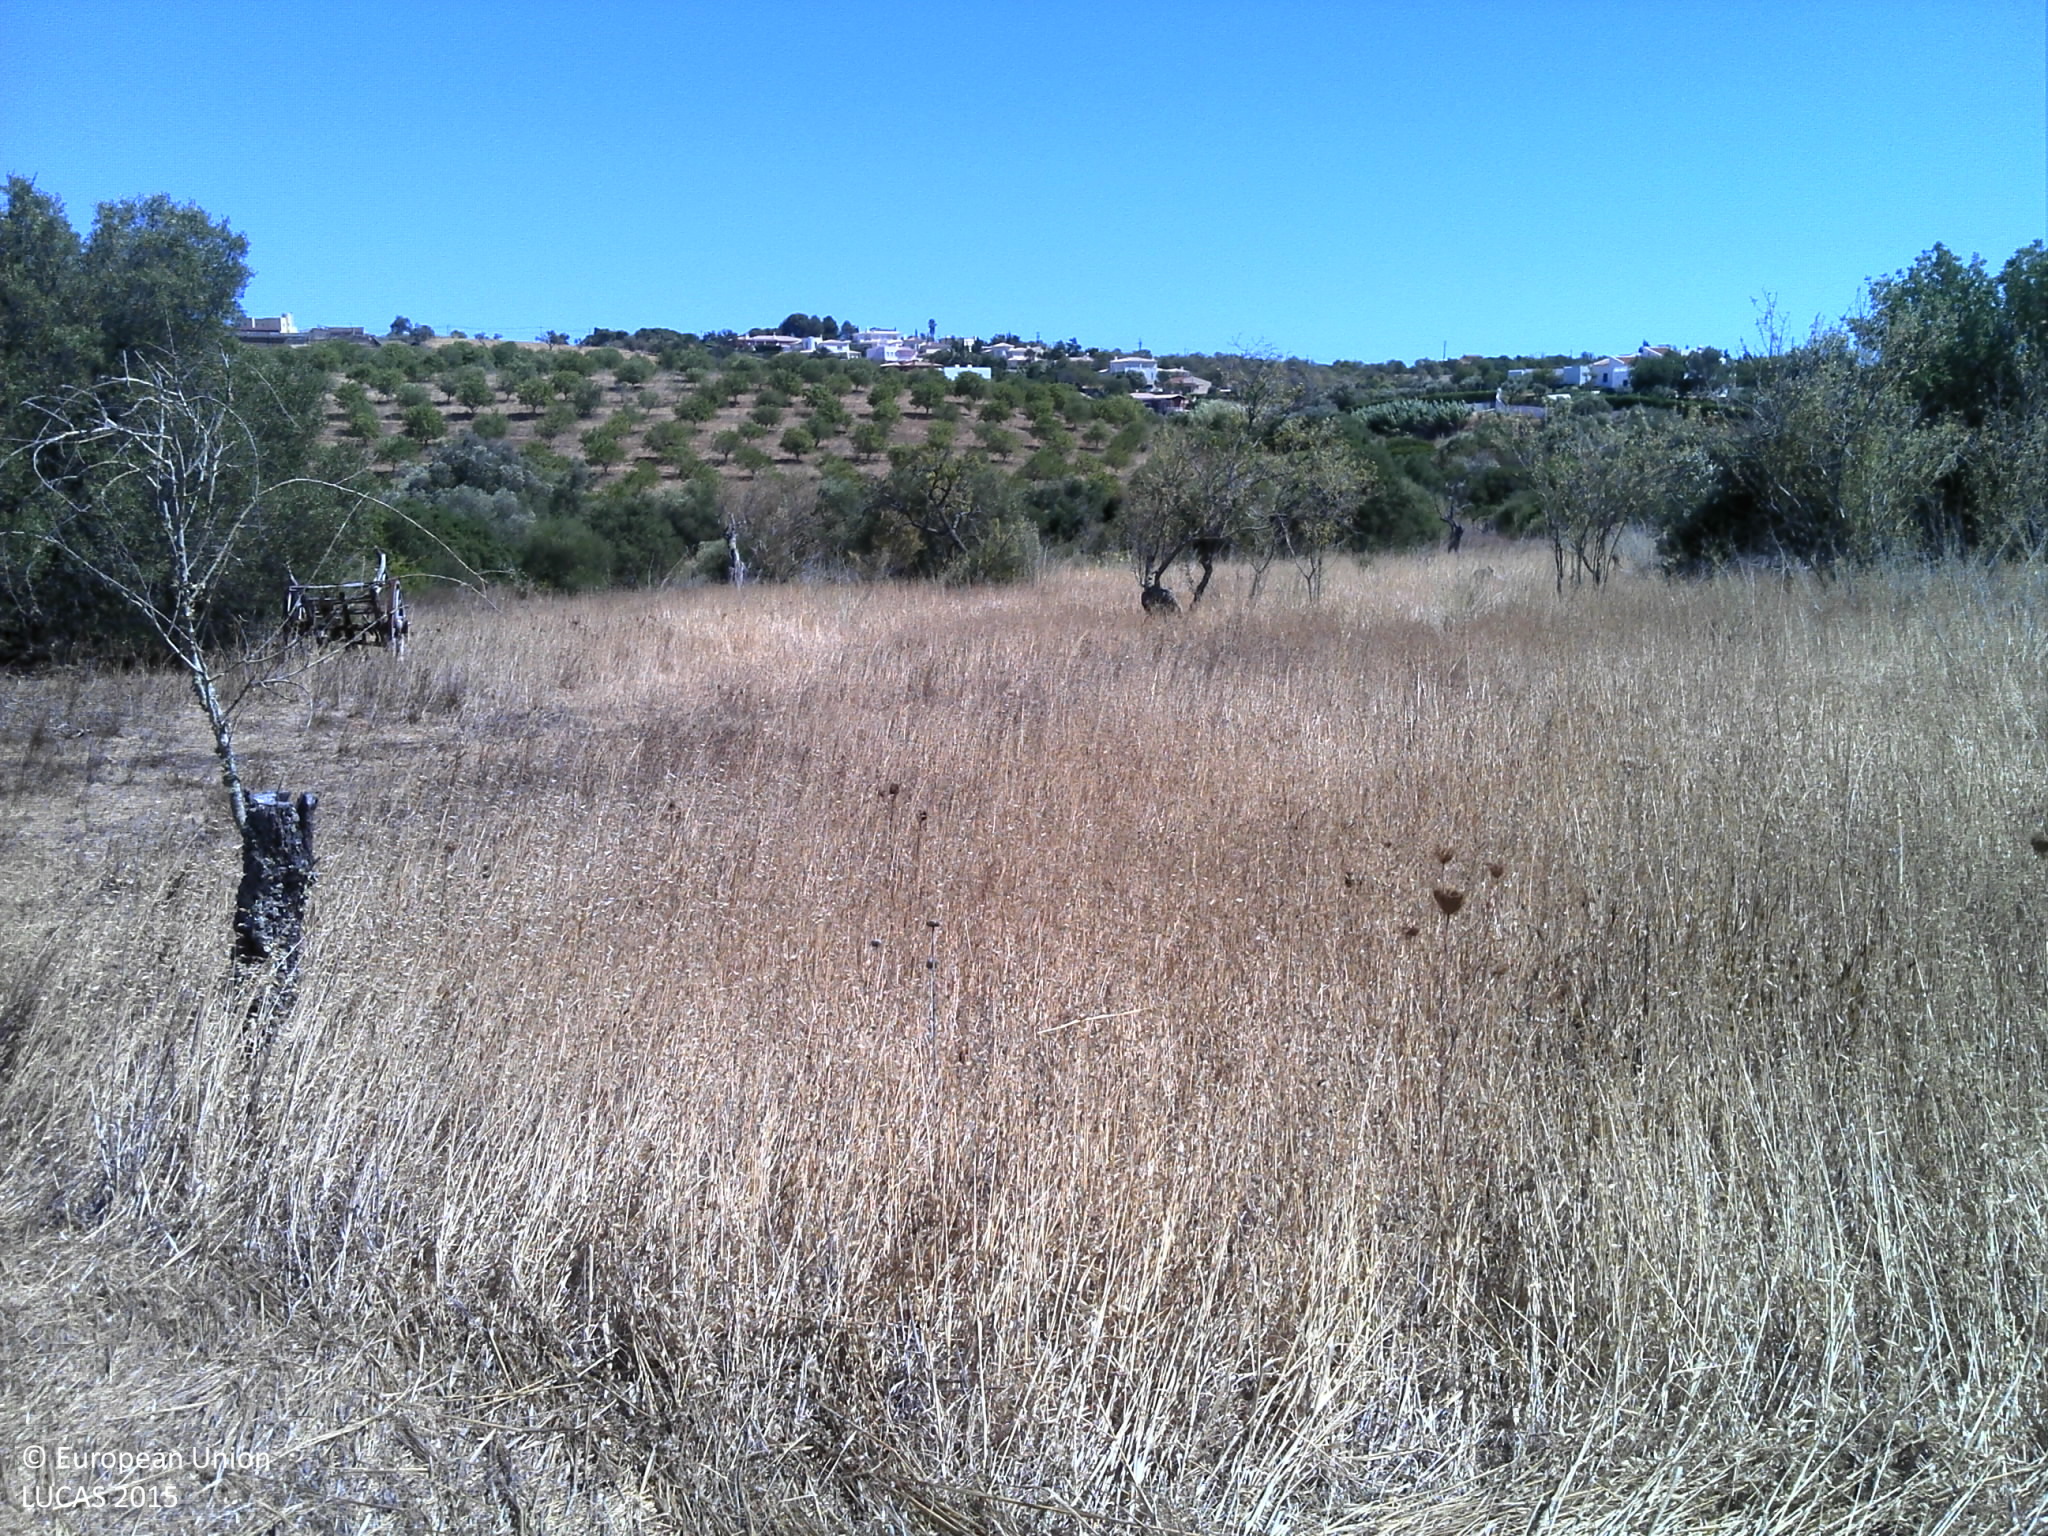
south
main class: Grassland
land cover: Grassland with sparse tree/shrub cover
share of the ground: 50 - 75 %
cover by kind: herbaceous plants 60 %, consolidated bare surface 35 %, broadleaved forest trees 5 %
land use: Agriculture (excluding fallow land and kitchen gardens)
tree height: > 5 m
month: July
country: PT
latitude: 37.1128
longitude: -8.7218
